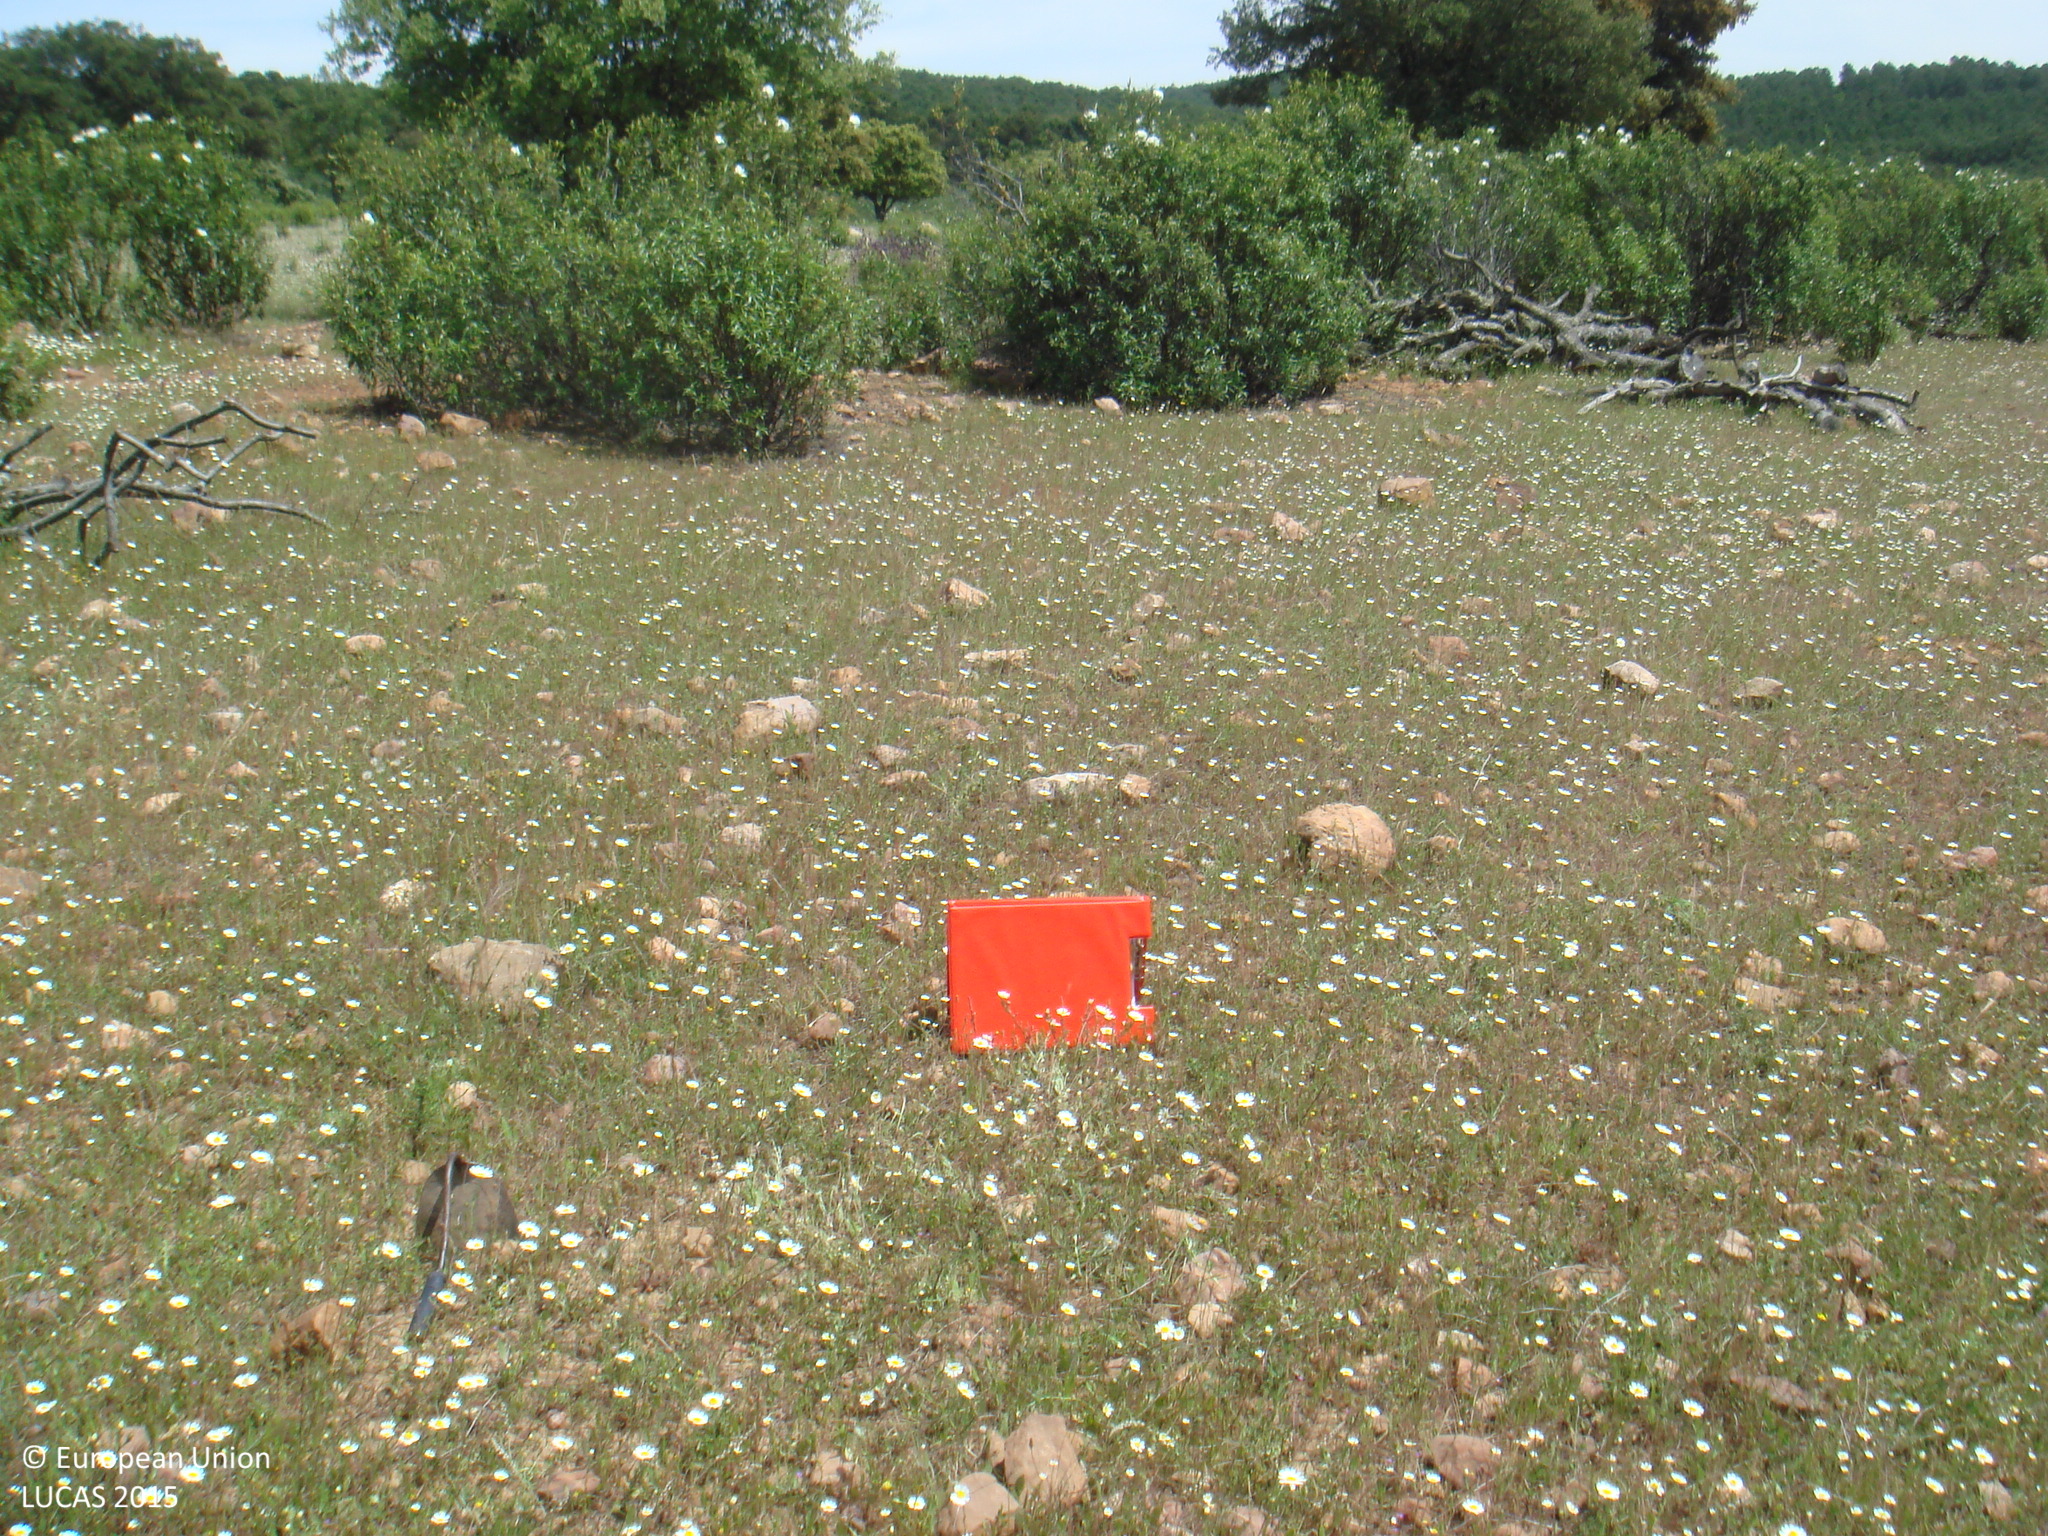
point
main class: Grassland
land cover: Spontaneously vegetated surfaces
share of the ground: > 75 %
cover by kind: herbaceous plants 75 %, unconsolidated bare surface 20 %, shrubs 5 %
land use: Agriculture (excluding fallow land and kitchen gardens)
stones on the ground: 10 - 25 %
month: May
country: ES
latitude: 38.2852
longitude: -5.0819
